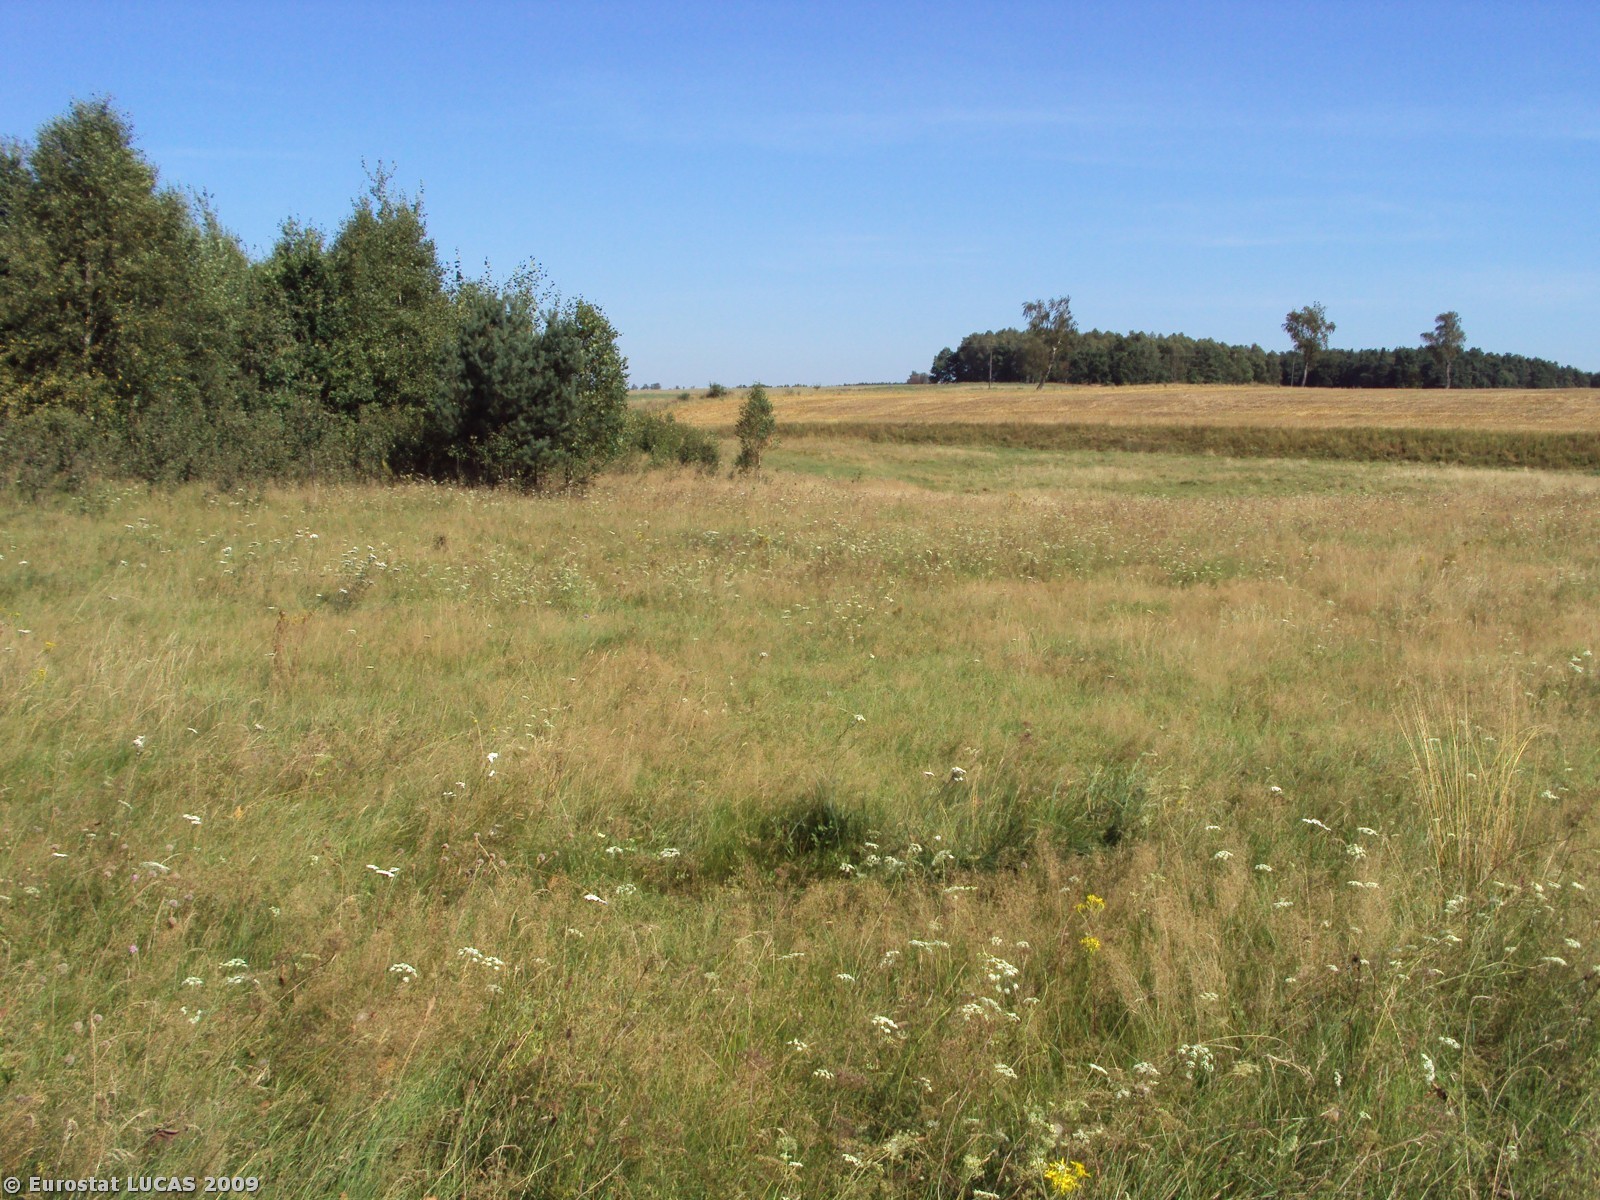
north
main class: Grassland
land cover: Grassland without tree/shrub cover
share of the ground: > 75 %
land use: Agriculture (excluding fallow land and kitchen gardens)
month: August
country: PL
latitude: 53.4877
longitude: 16.3511
